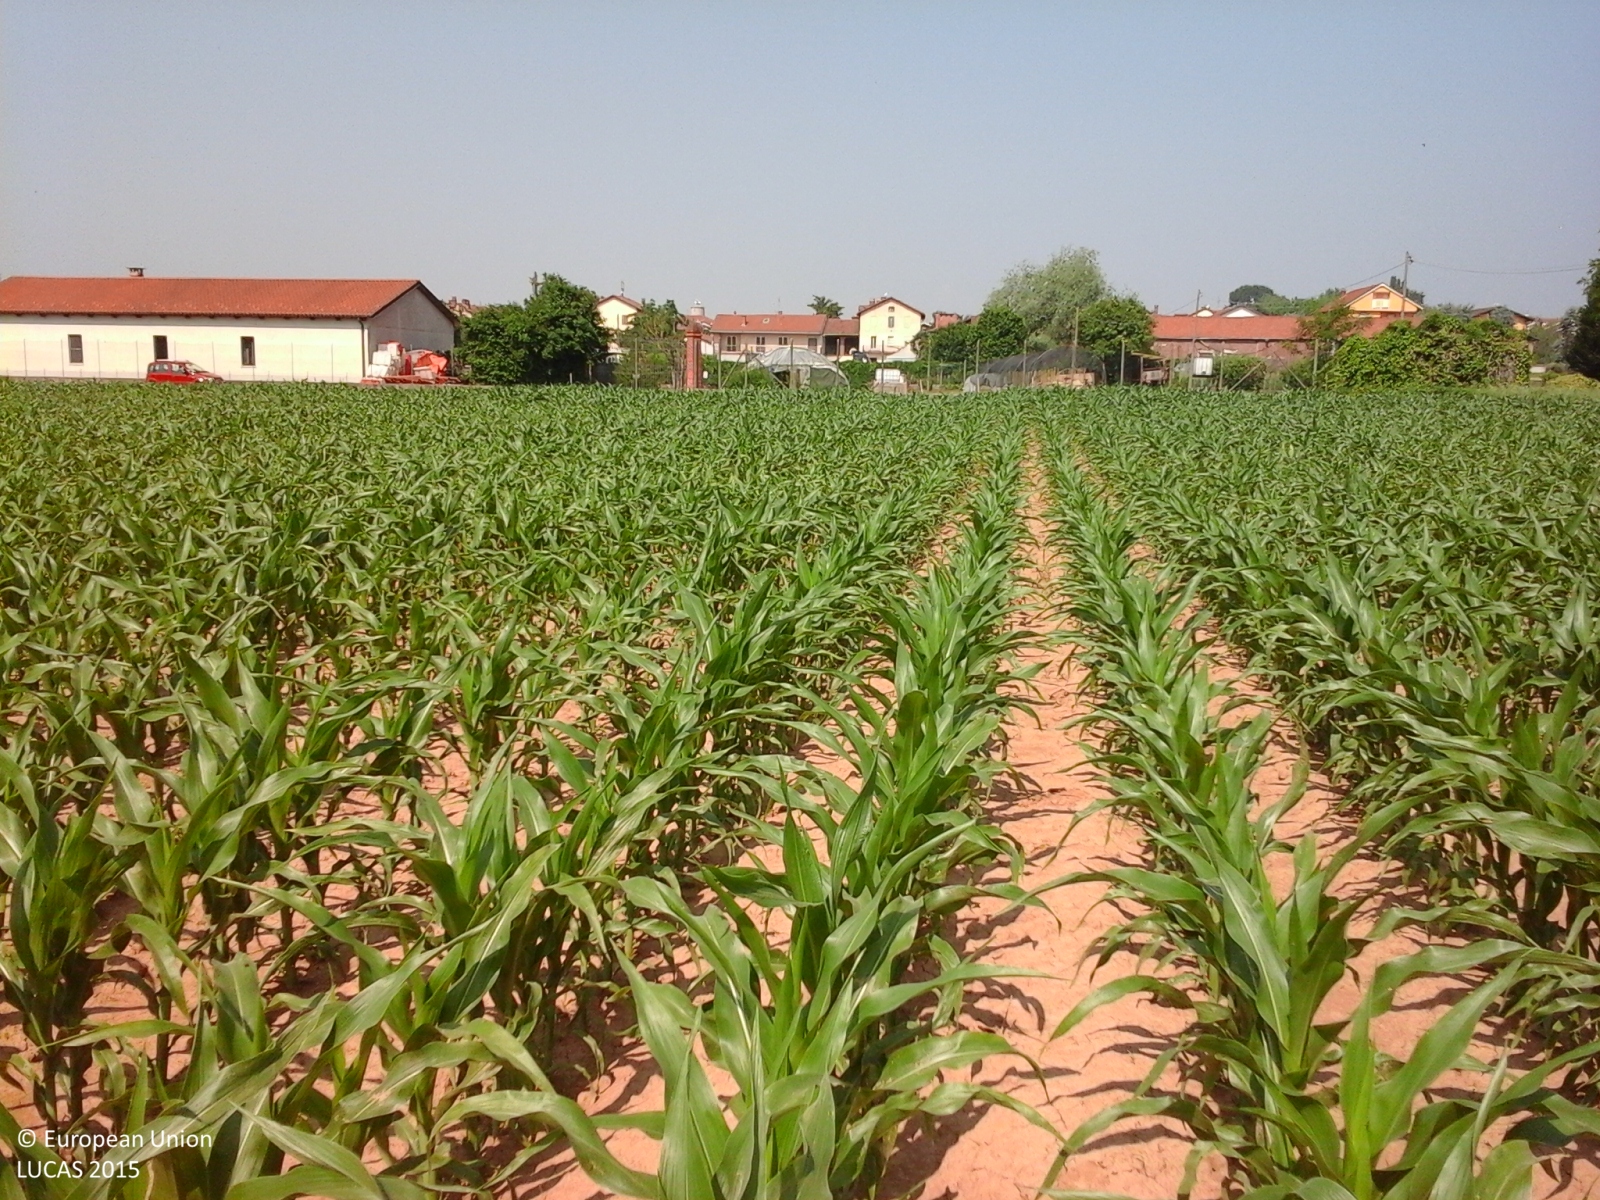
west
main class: Cropland
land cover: Maize
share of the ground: > 75 %
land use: Agriculture (excluding fallow land and kitchen gardens)
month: June
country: IT
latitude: 44.9763
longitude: 7.7849
